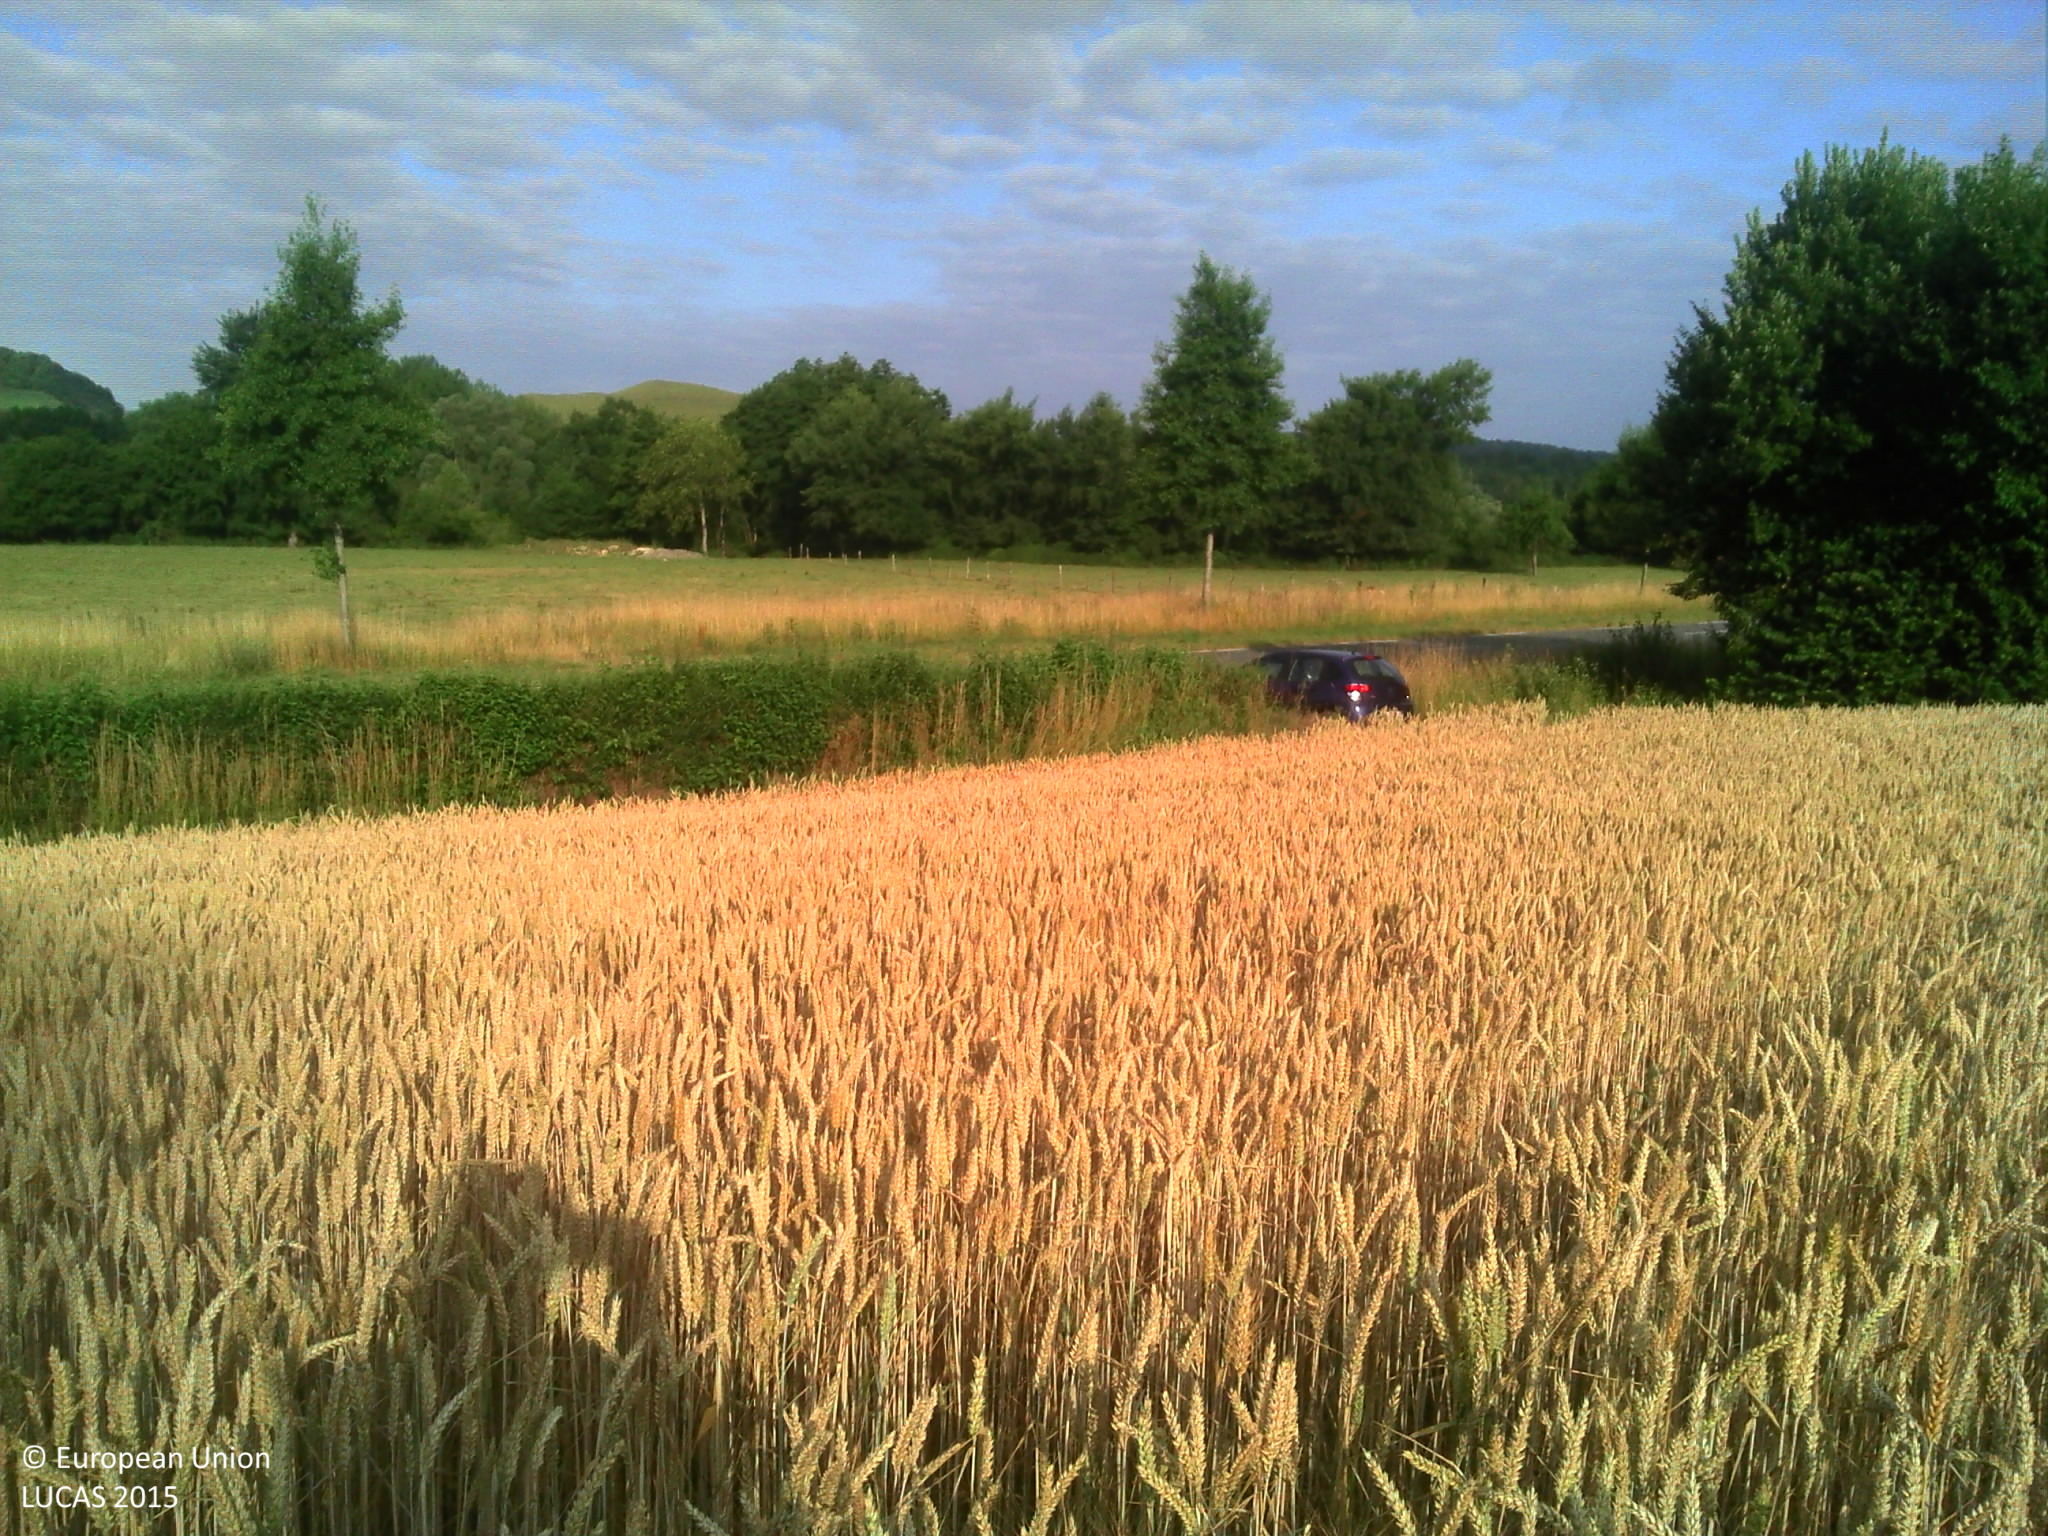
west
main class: Cropland
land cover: Common wheat
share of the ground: > 75 %
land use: Agriculture (excluding fallow land and kitchen gardens)
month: July
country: FR
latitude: 49.8993
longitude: 1.6990
